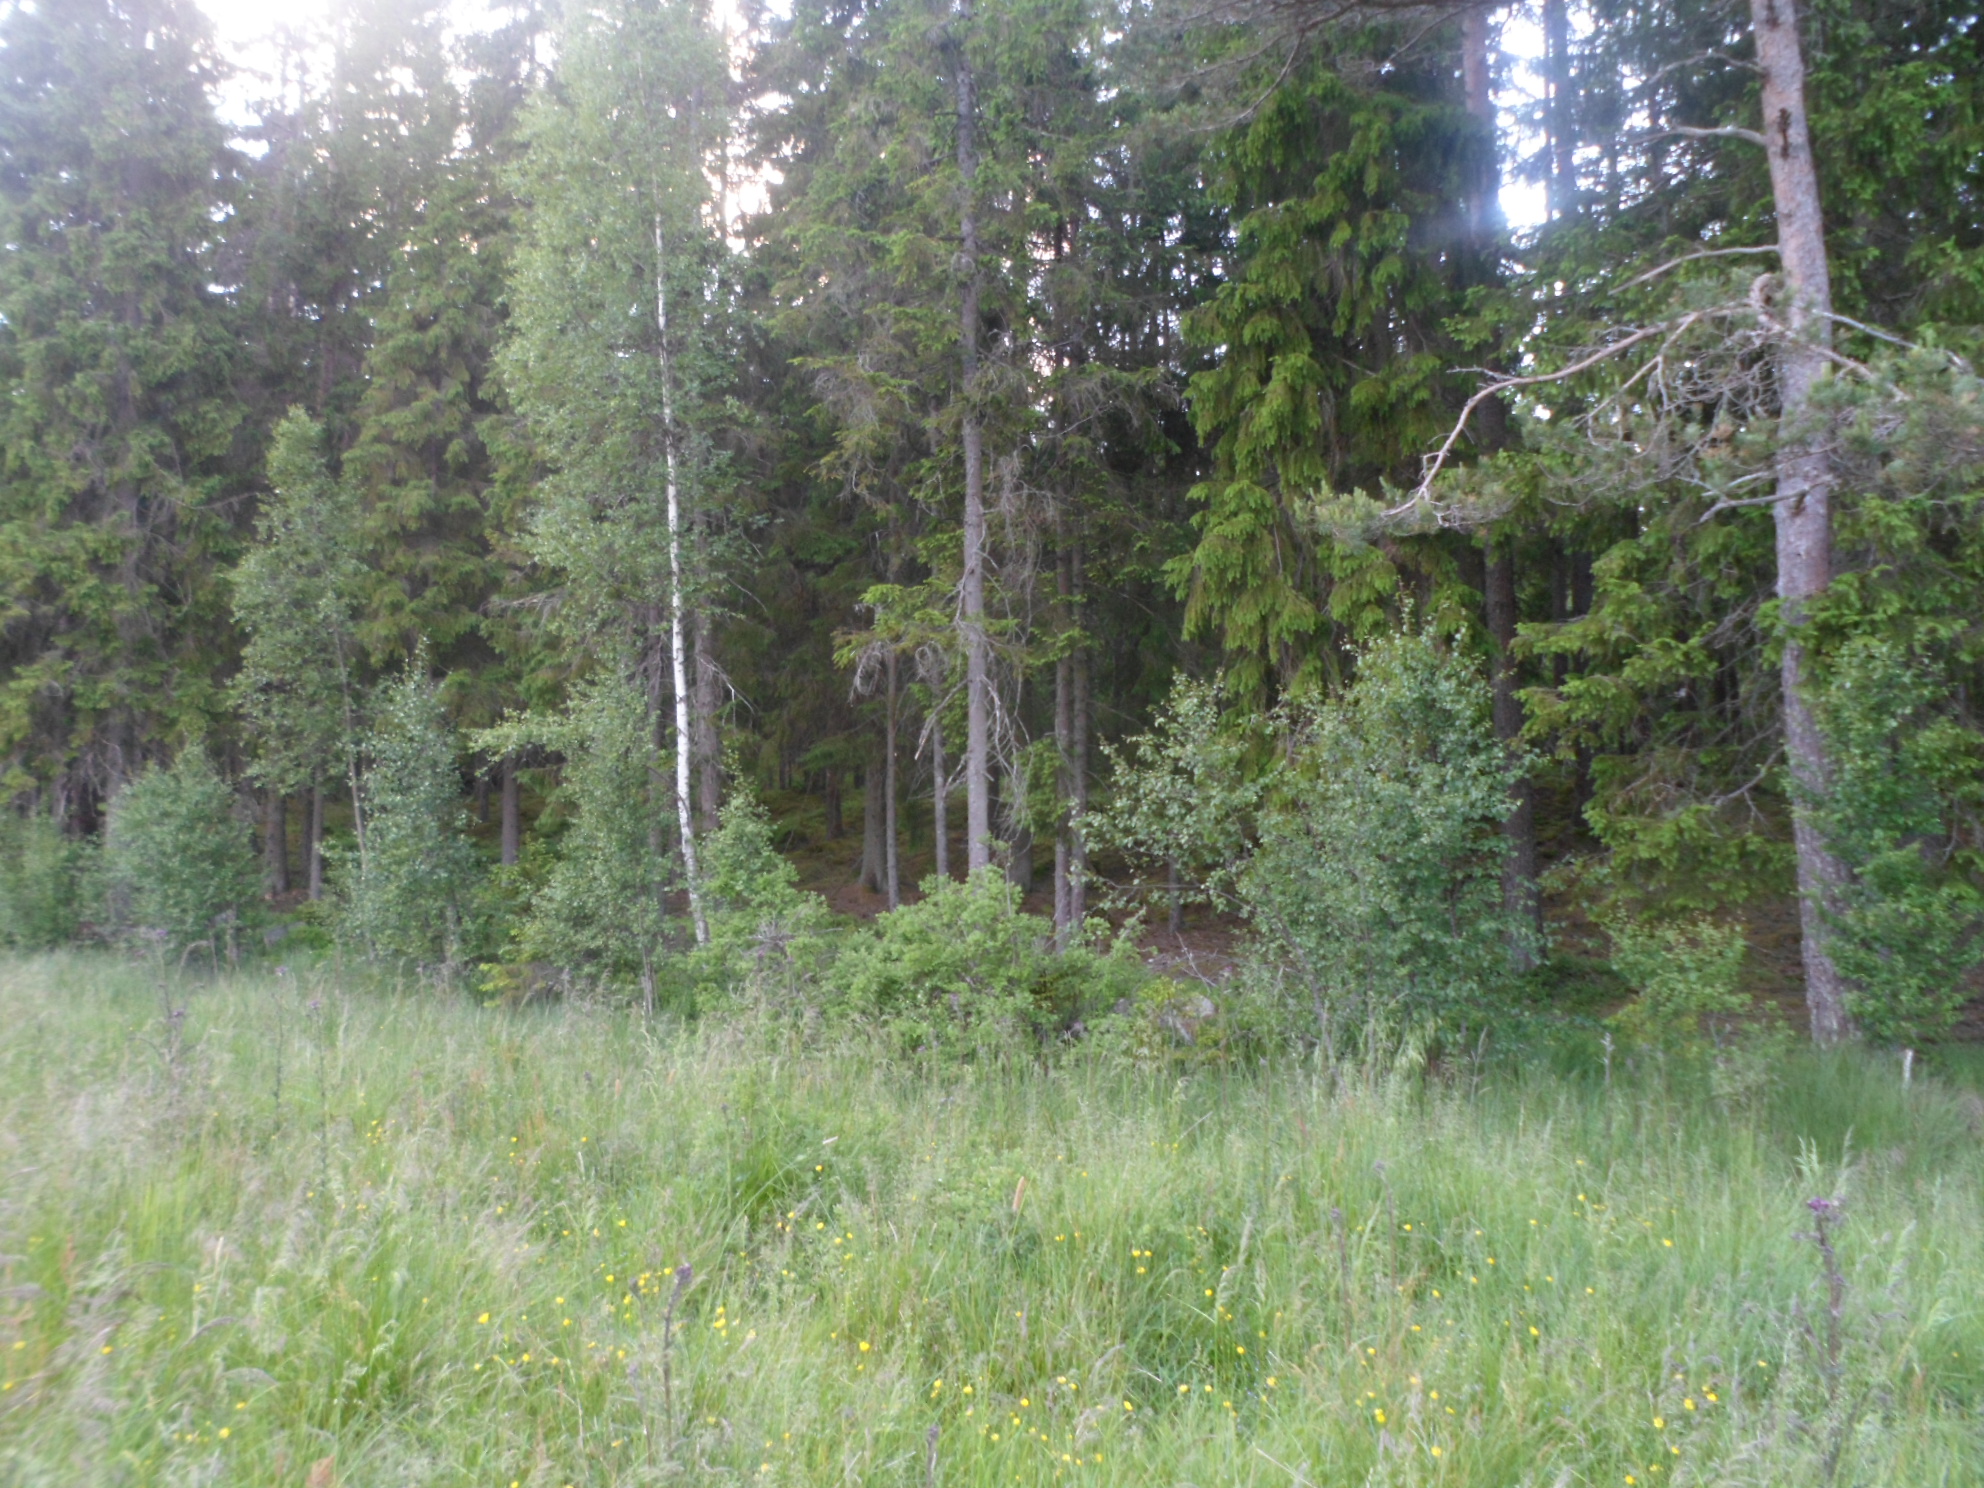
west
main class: Grassland
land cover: Grassland without tree/shrub cover
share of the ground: > 75 %
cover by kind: herbaceous plants 100 %
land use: Agriculture (excluding fallow land and kitchen gardens)
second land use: Amenities, museums, leisure
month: July
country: SE
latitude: 57.5713
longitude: 14.3928
